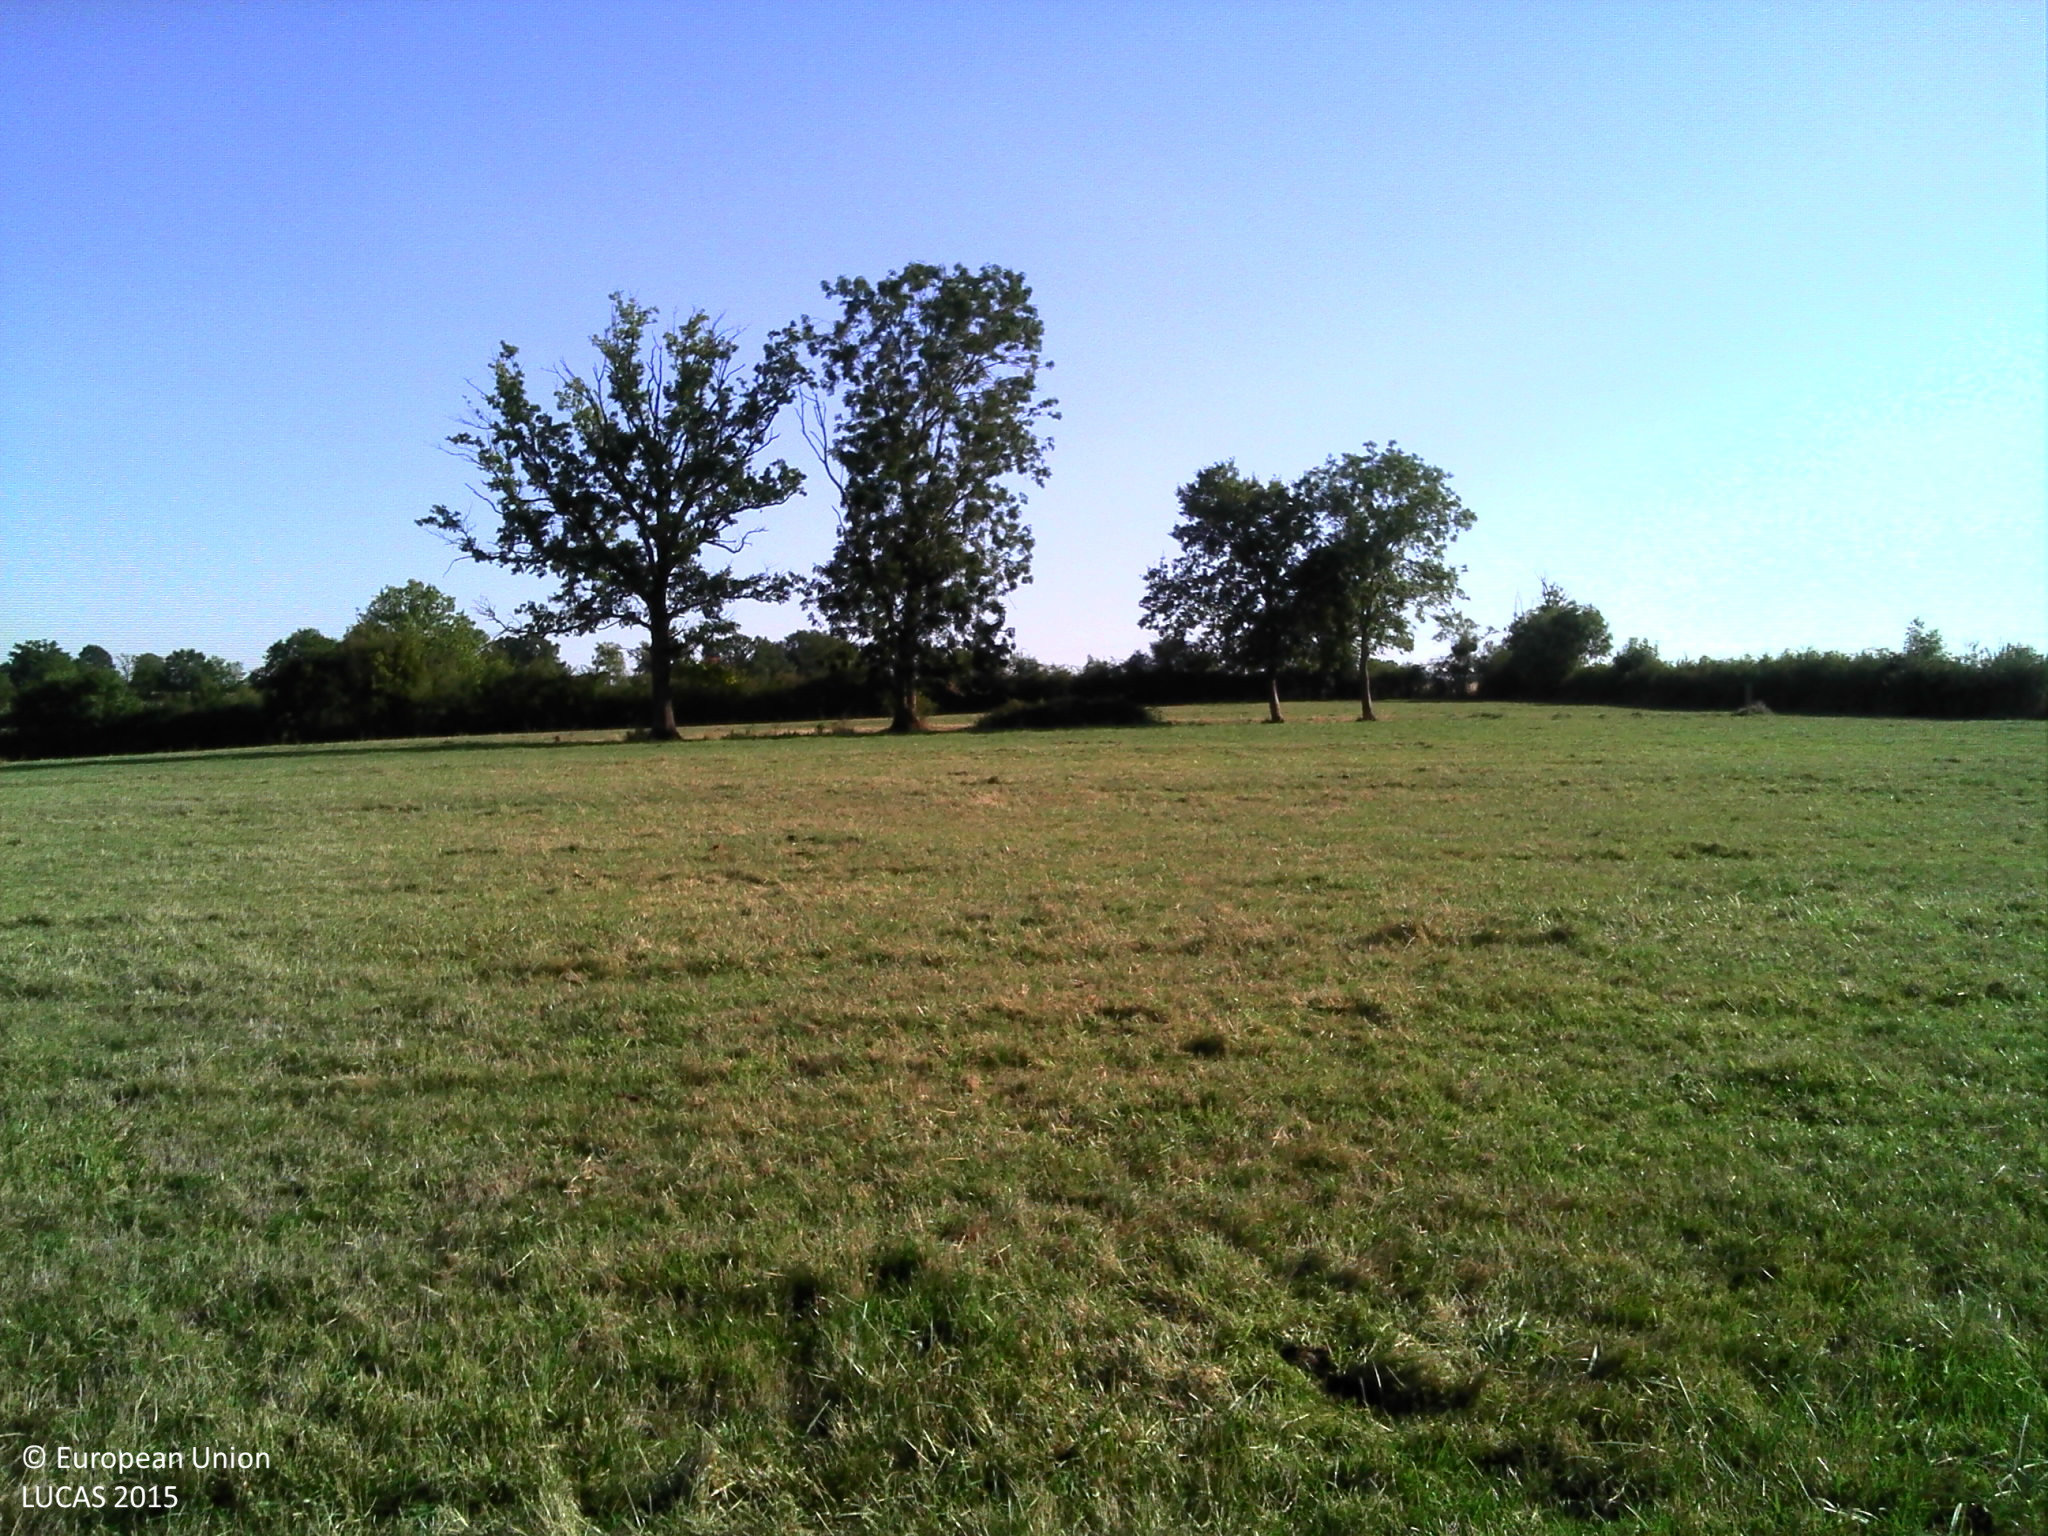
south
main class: Grassland
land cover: Grassland without tree/shrub cover
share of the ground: > 75 %
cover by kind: herbaceous plants 100 %
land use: Agriculture (excluding fallow land and kitchen gardens)
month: September
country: FR
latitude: 47.5169
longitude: 4.3017
